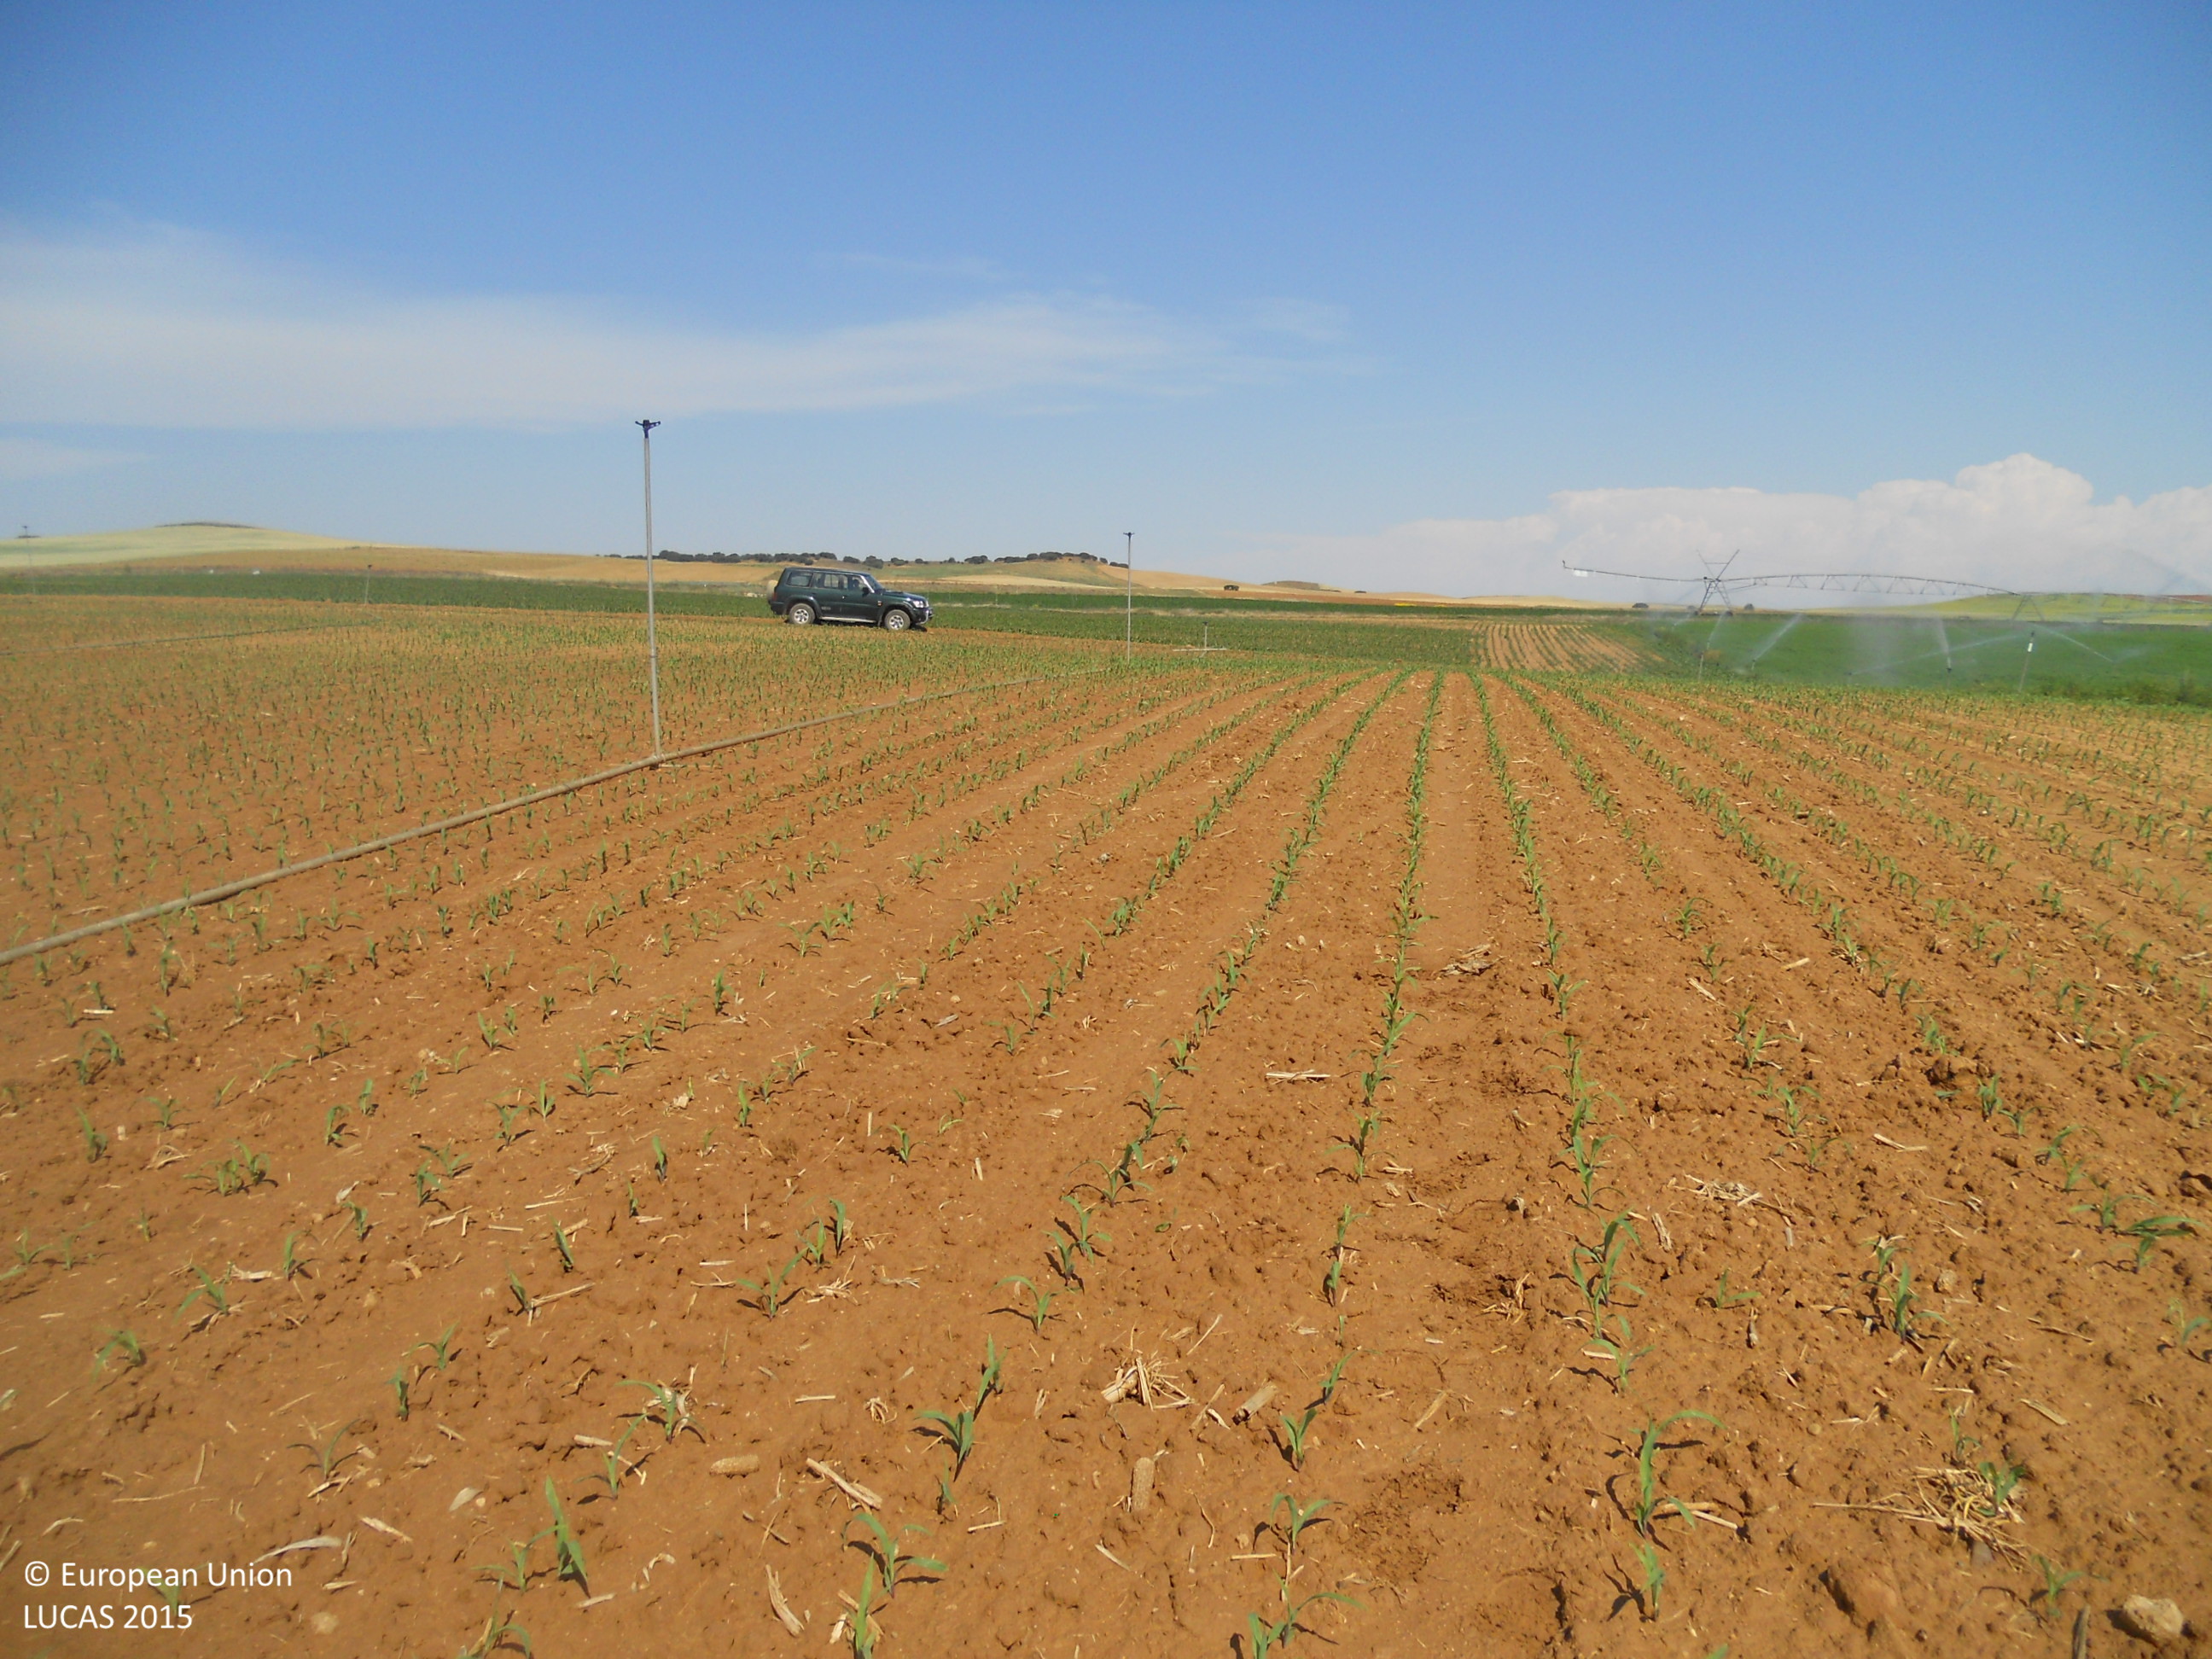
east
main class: Cropland
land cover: Maize
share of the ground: < 10 %
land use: Agriculture (excluding fallow land and kitchen gardens)
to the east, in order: Maize; Tracks; Maize; Grass margins; Ditches and canals; Grass margins; Maize
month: June
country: ES
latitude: 42.2036
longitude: -5.5088
